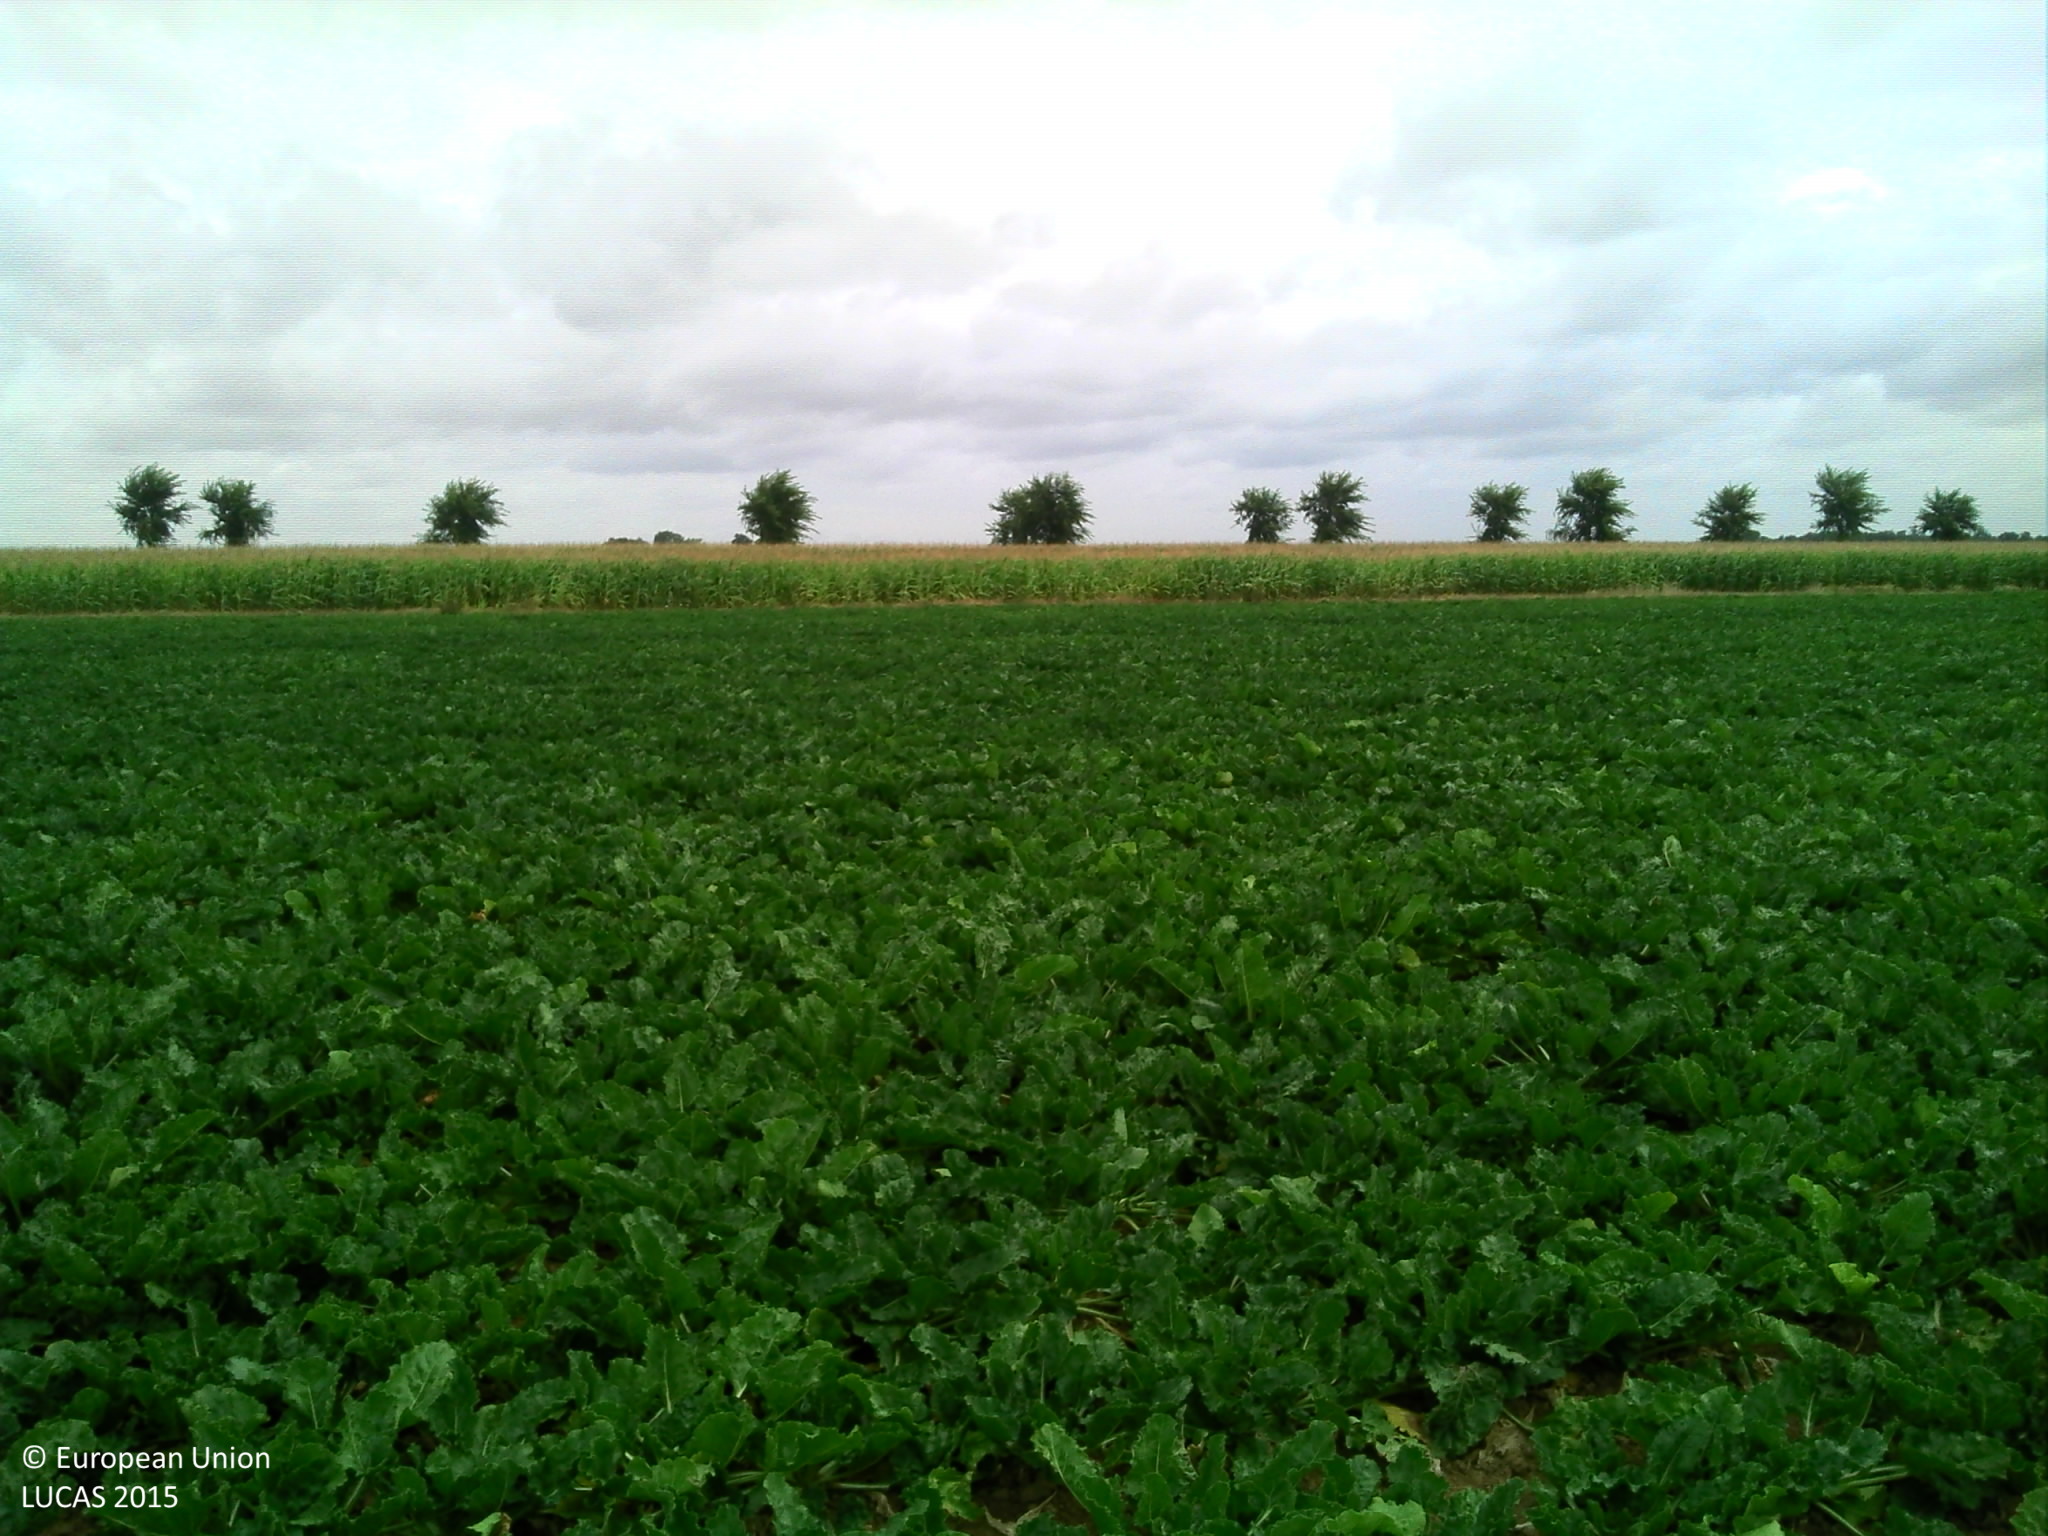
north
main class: Cropland
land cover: Sugar beet
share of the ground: > 75 %
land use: Agriculture (excluding fallow land and kitchen gardens)
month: July
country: FR
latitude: 48.6302
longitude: 2.6766
